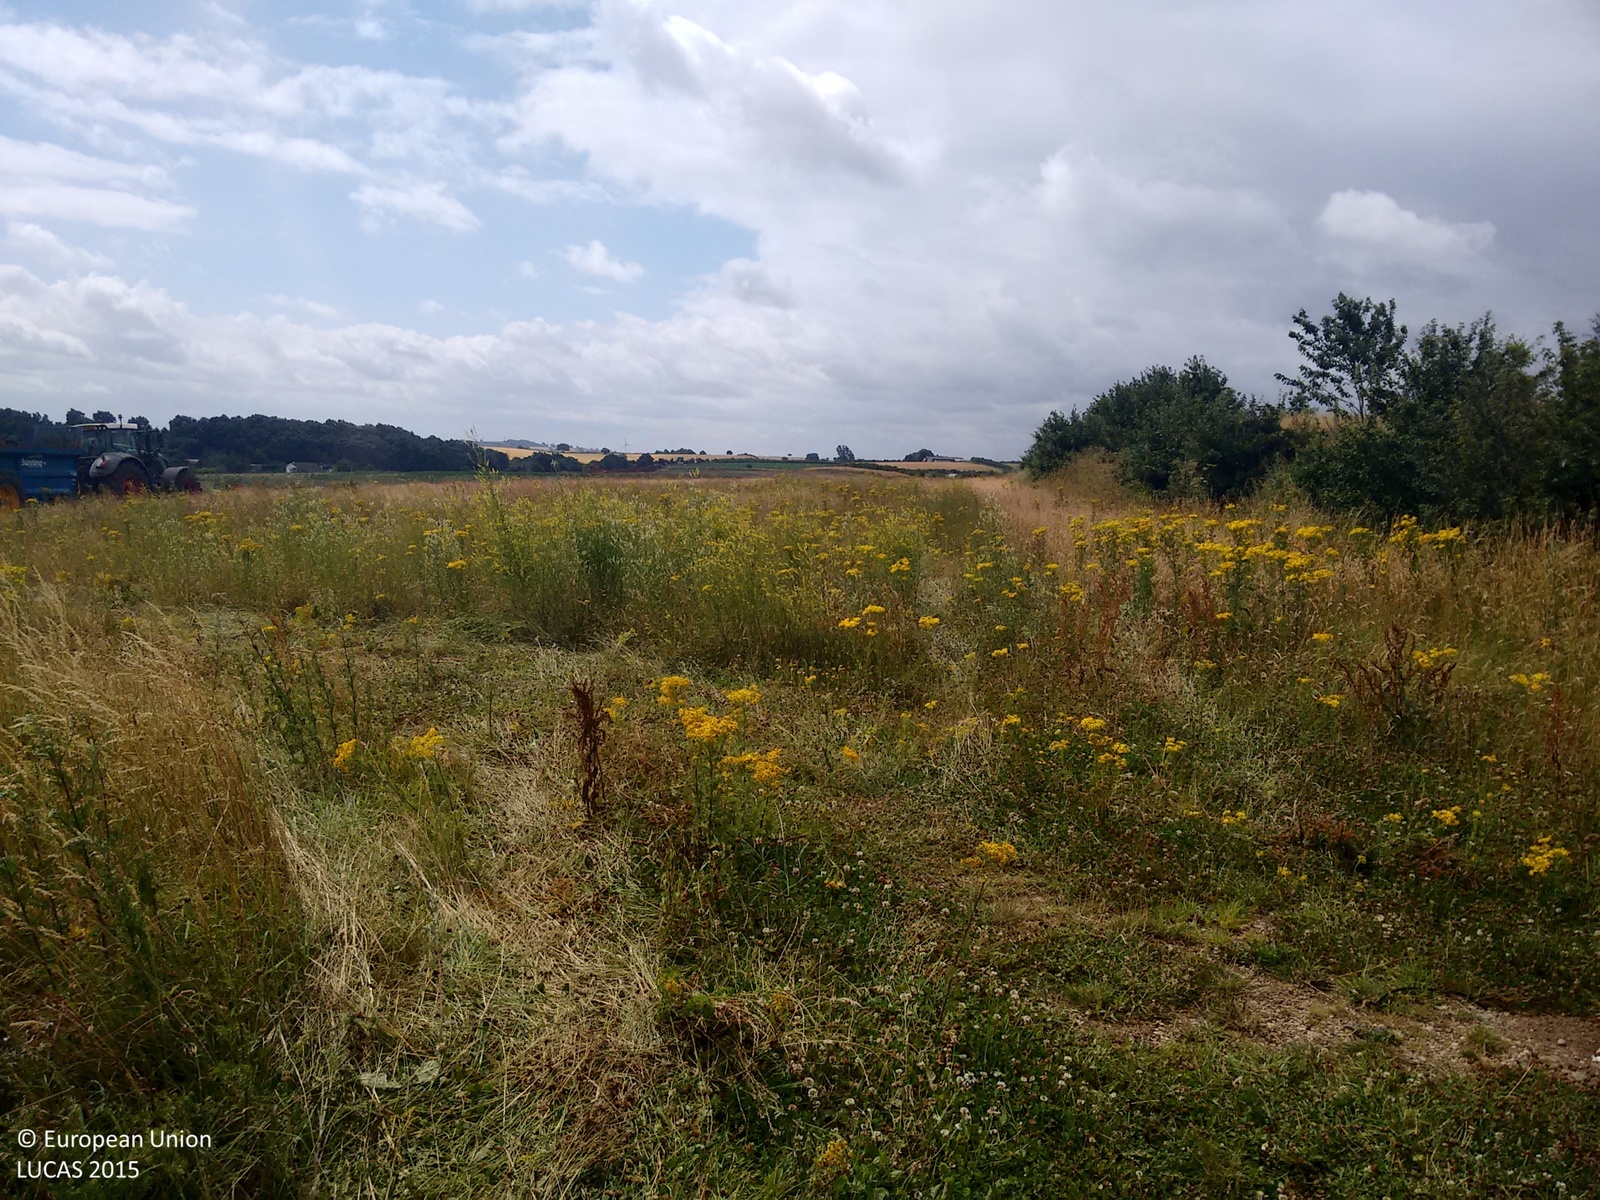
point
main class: Grassland
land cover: Spontaneously vegetated surfaces
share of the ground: > 75 %
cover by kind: herbaceous plants 100 %
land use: Agriculture (excluding fallow land and kitchen gardens)
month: July
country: GB
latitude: 53.1296
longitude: -1.0593
